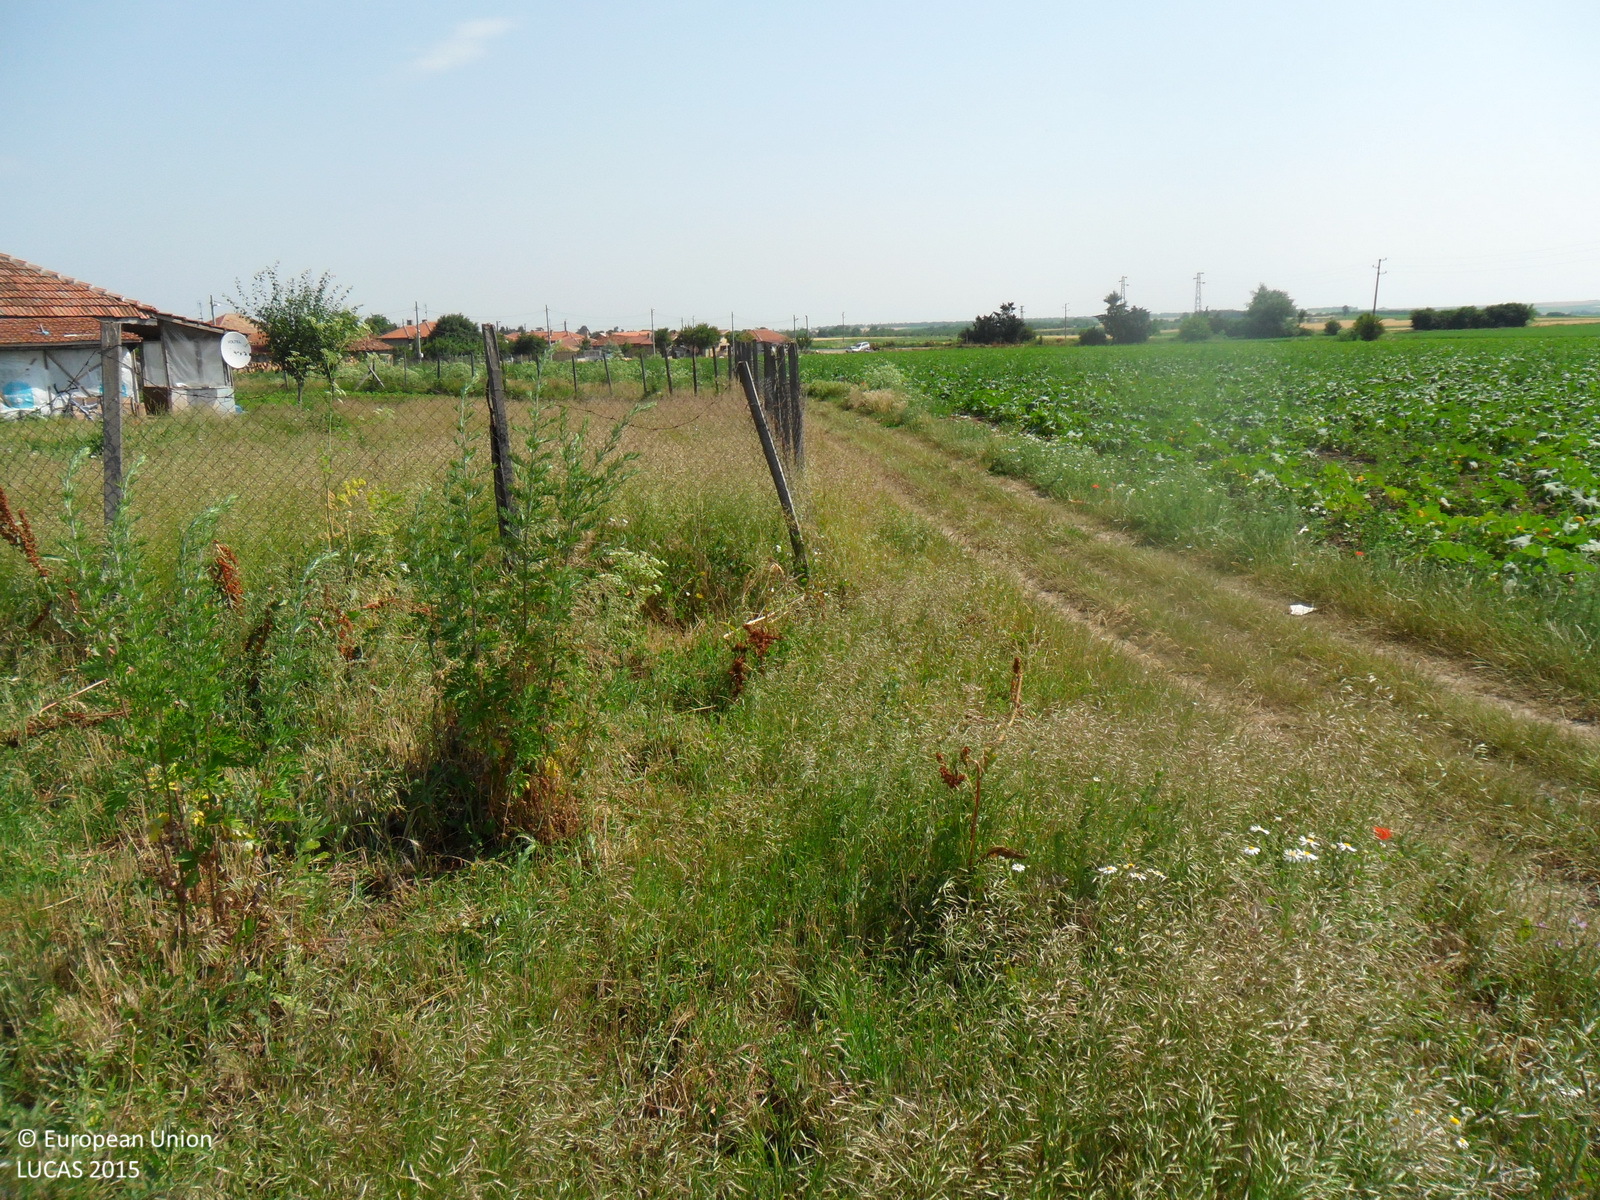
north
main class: Cropland
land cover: Other fresh vegetables
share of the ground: 50 - 75 %
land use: Agriculture (excluding fallow land and kitchen gardens)
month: June
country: BG
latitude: 43.6661
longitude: 26.9214
